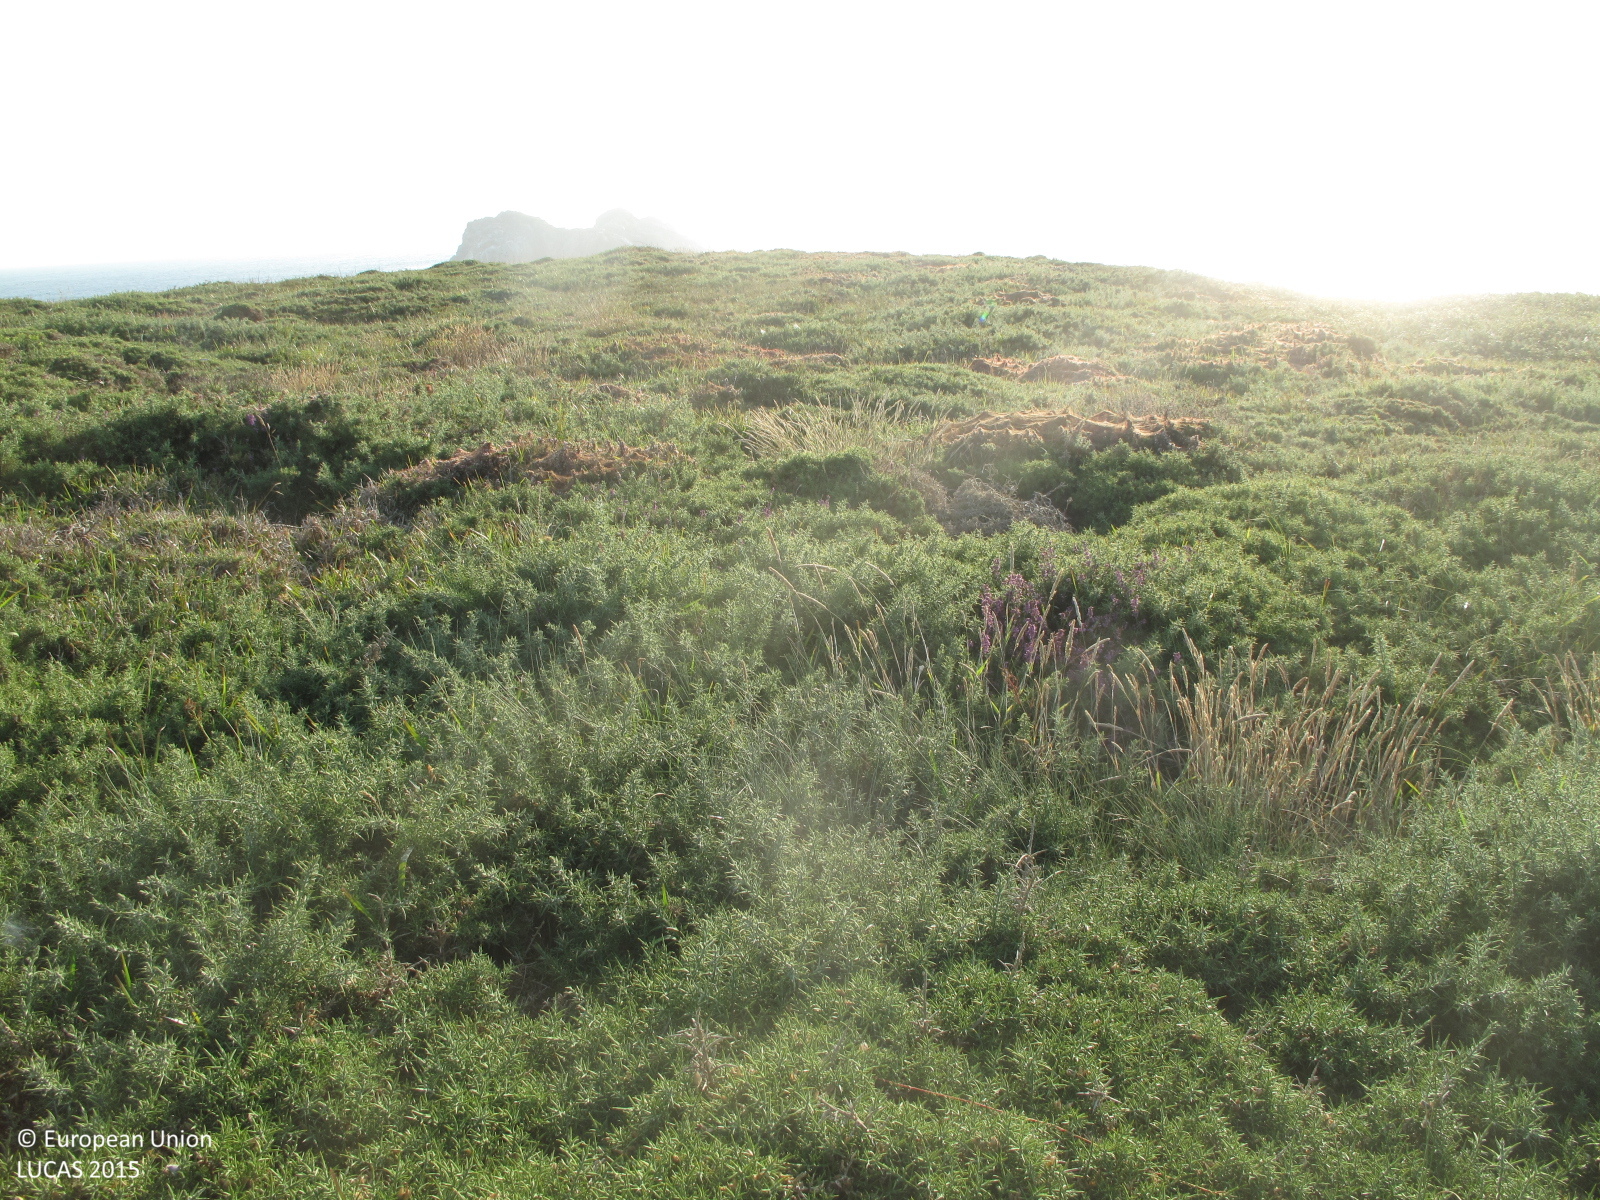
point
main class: Shrubland
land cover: Shrubland without tree cover
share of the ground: > 75 %
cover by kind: shrubs 100 %
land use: Semi-natural and natural areas not in use
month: July
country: ES
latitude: 43.5132
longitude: -8.3275
